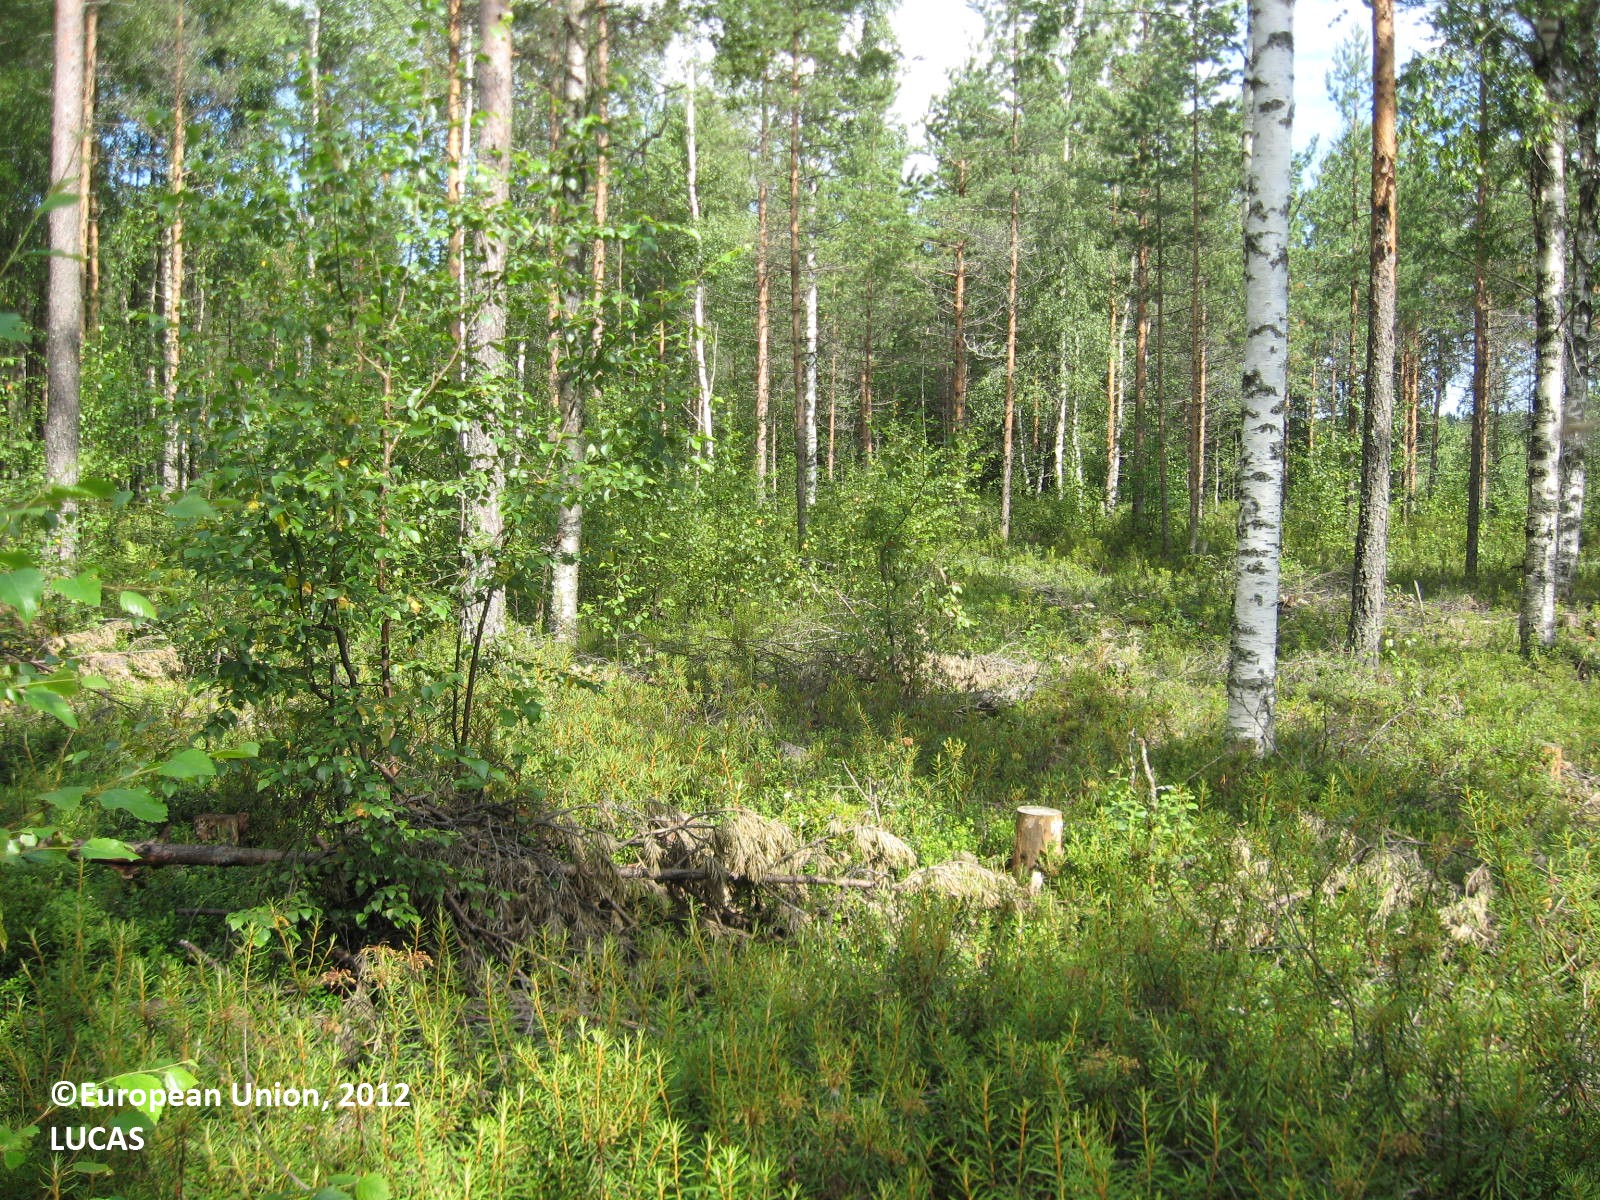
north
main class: Woodland
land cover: Pine dominated coniferous woodland
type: boreal forest
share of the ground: 50 - 75 %
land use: Forestry
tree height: > 5 m
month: July
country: FI
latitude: 62.0741
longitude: 22.6751
